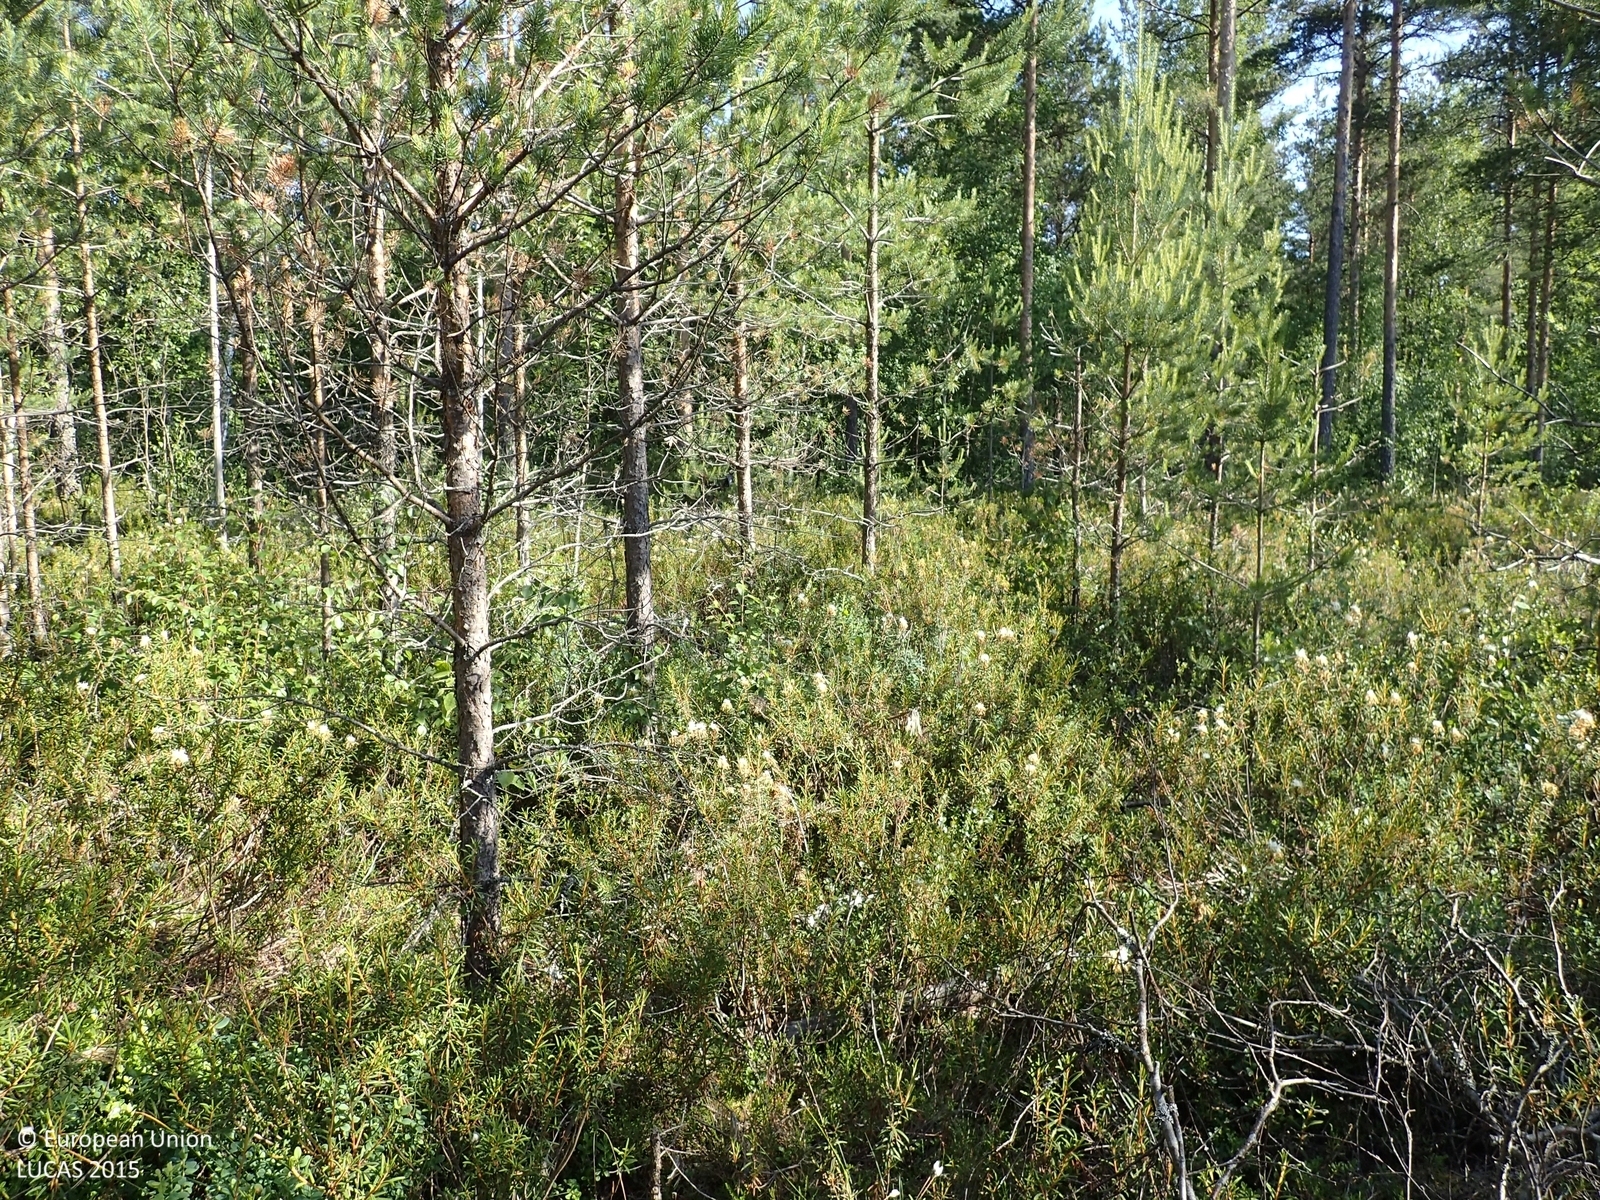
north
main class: Woodland
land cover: Pine dominated coniferous woodland
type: boreal forest
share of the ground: 50 - 75 %
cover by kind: coniferous forest trees 50 %, shrubs 50 %
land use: Forestry
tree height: < 5 m
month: July
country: FI
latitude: 62.7638
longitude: 21.6178
